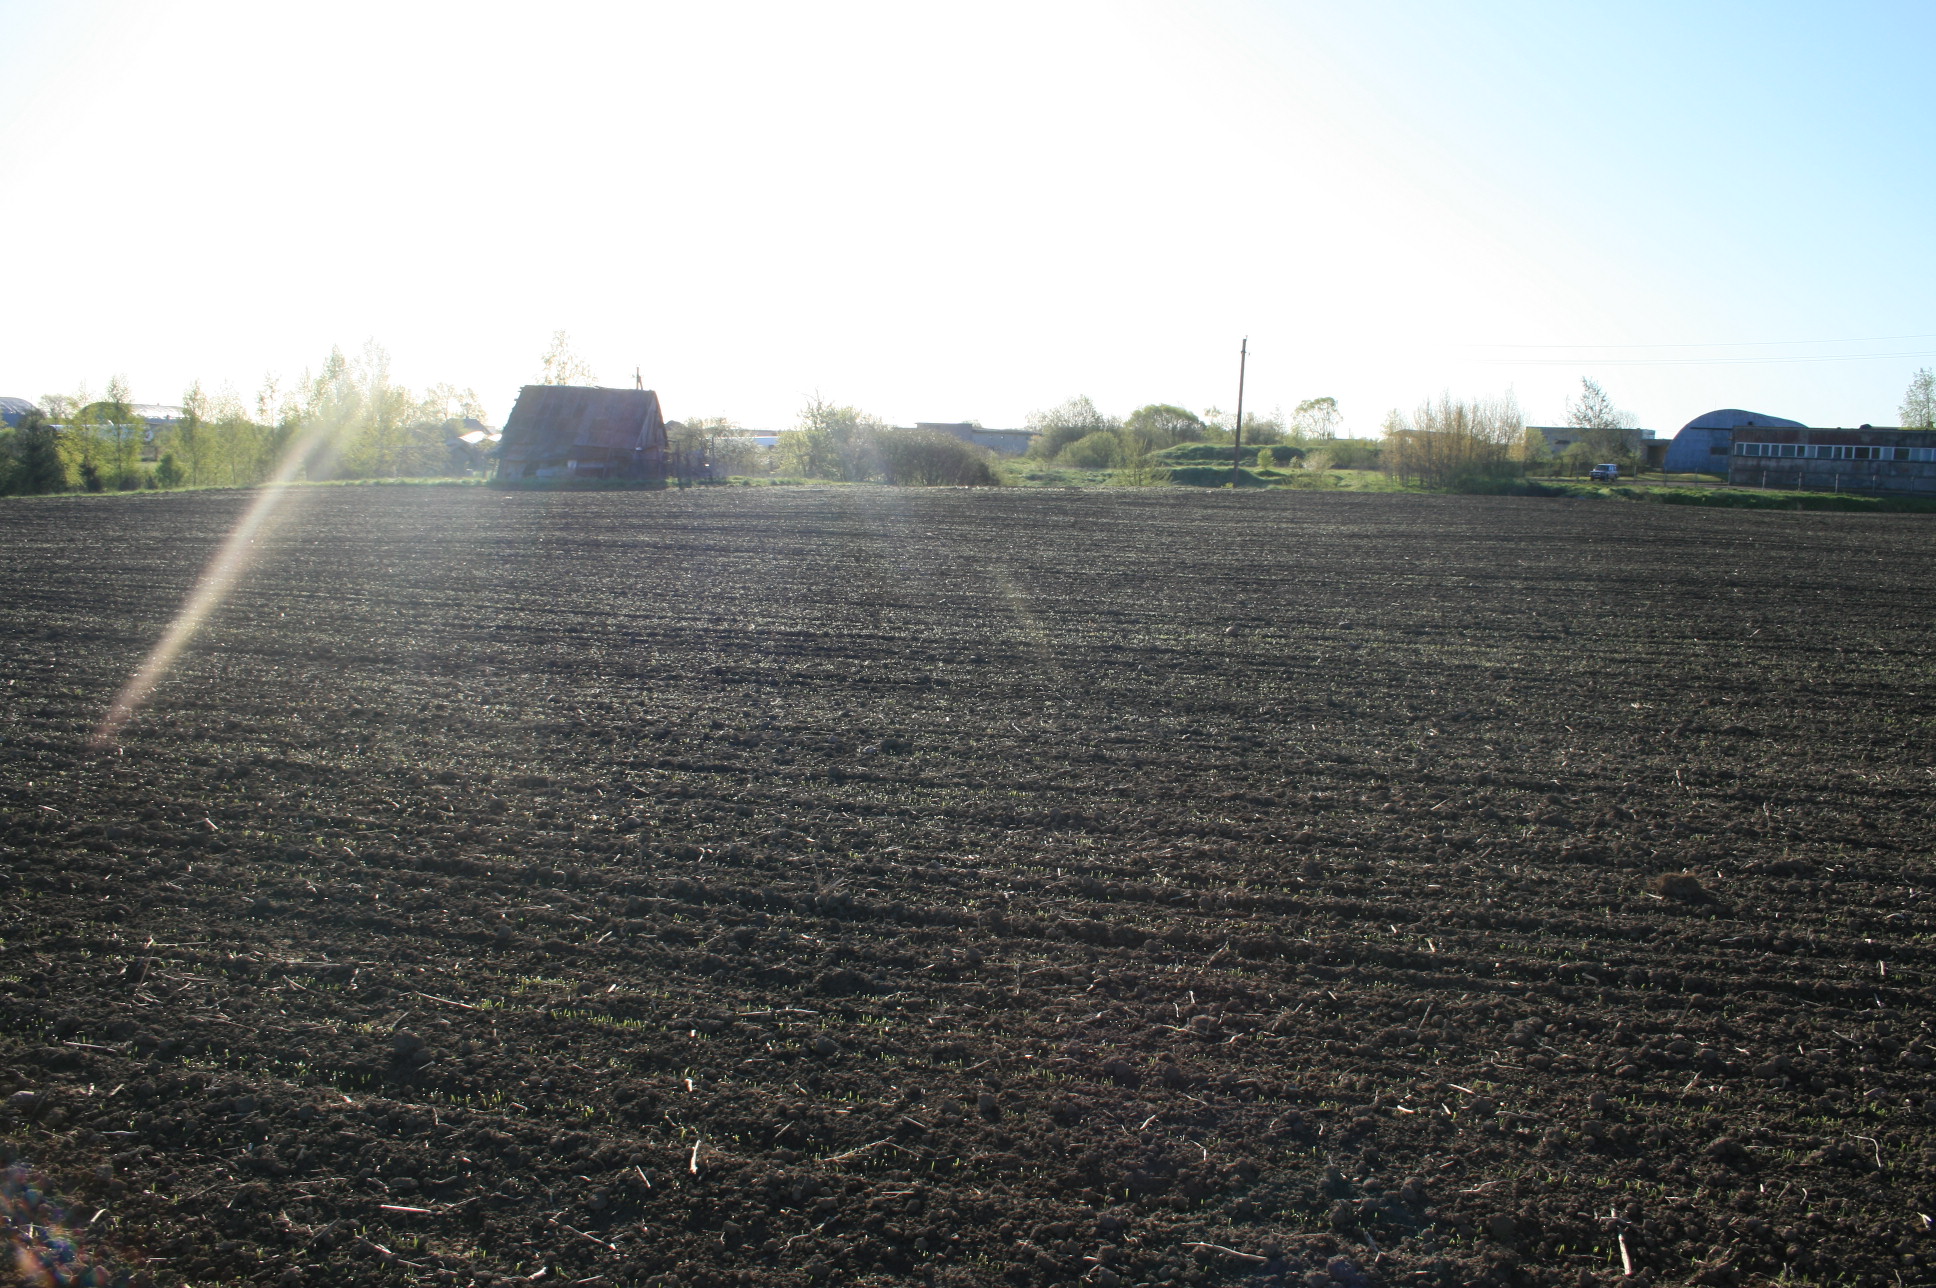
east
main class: Cropland
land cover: Common wheat
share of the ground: 10 - 25 %
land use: Agriculture (excluding fallow land and kitchen gardens)
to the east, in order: Common wheat; Cherry fruit; Grassland without tree/shrub cover; Apple fruit; Grassland without tree/shrub cover; Ditches and canals; Grassland without tree/shrub cover; Electric lines; Ditches and canals; Grassland without tree/shrub cover; Artificial constructions in urban areas
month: May
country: LT
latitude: 56.2696
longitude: 21.4915
